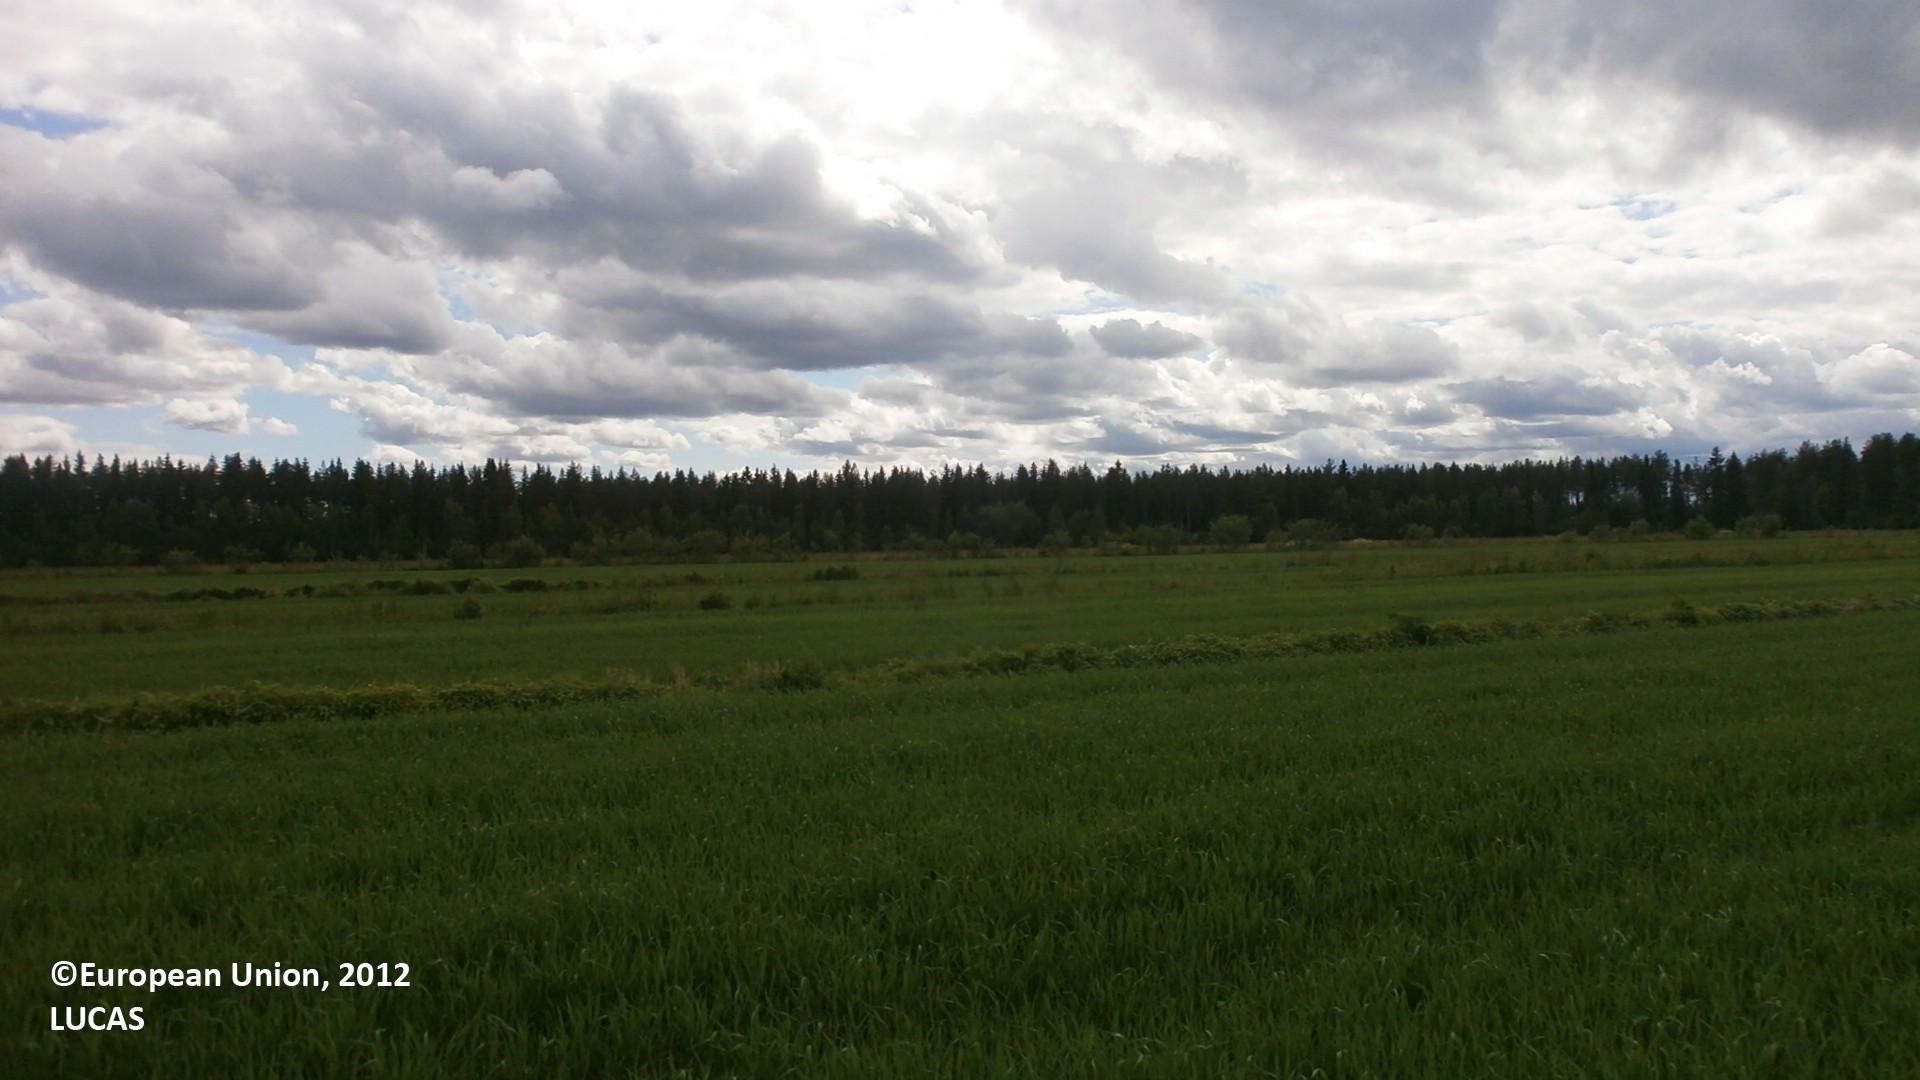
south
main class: Cropland
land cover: Oats
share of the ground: > 75 %
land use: Agriculture (excluding fallow land and kitchen gardens)
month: June
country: FI
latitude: 64.2770
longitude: 24.9278
